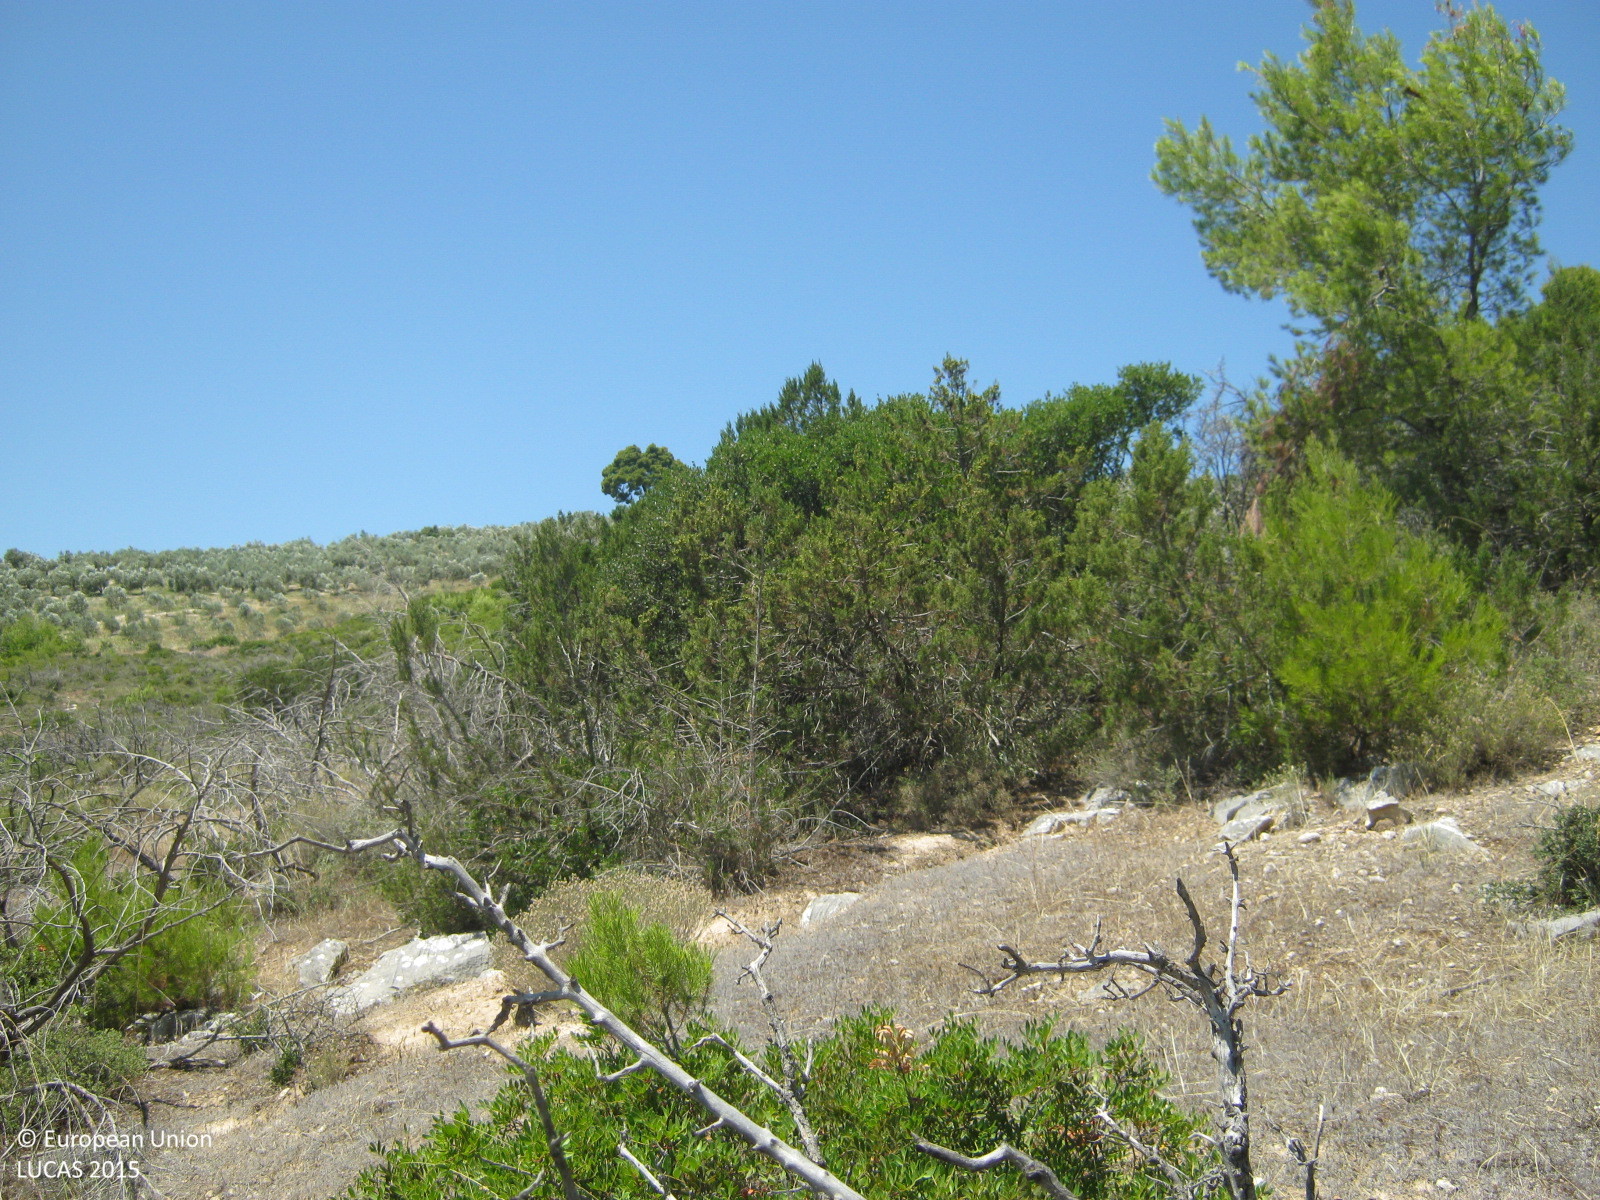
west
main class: Shrubland
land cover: Shrubland with sparse tree cover
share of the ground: 50 - 75 %
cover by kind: shrubs 55 %, unconsolidated bare surface 30 %, herbaceous plants 10 %, coniferous forest trees 5 %
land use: Agriculture (excluding fallow land and kitchen gardens)
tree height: < 5 m
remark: Burnt area
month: July
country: GR
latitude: 37.8412
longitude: 22.8678
